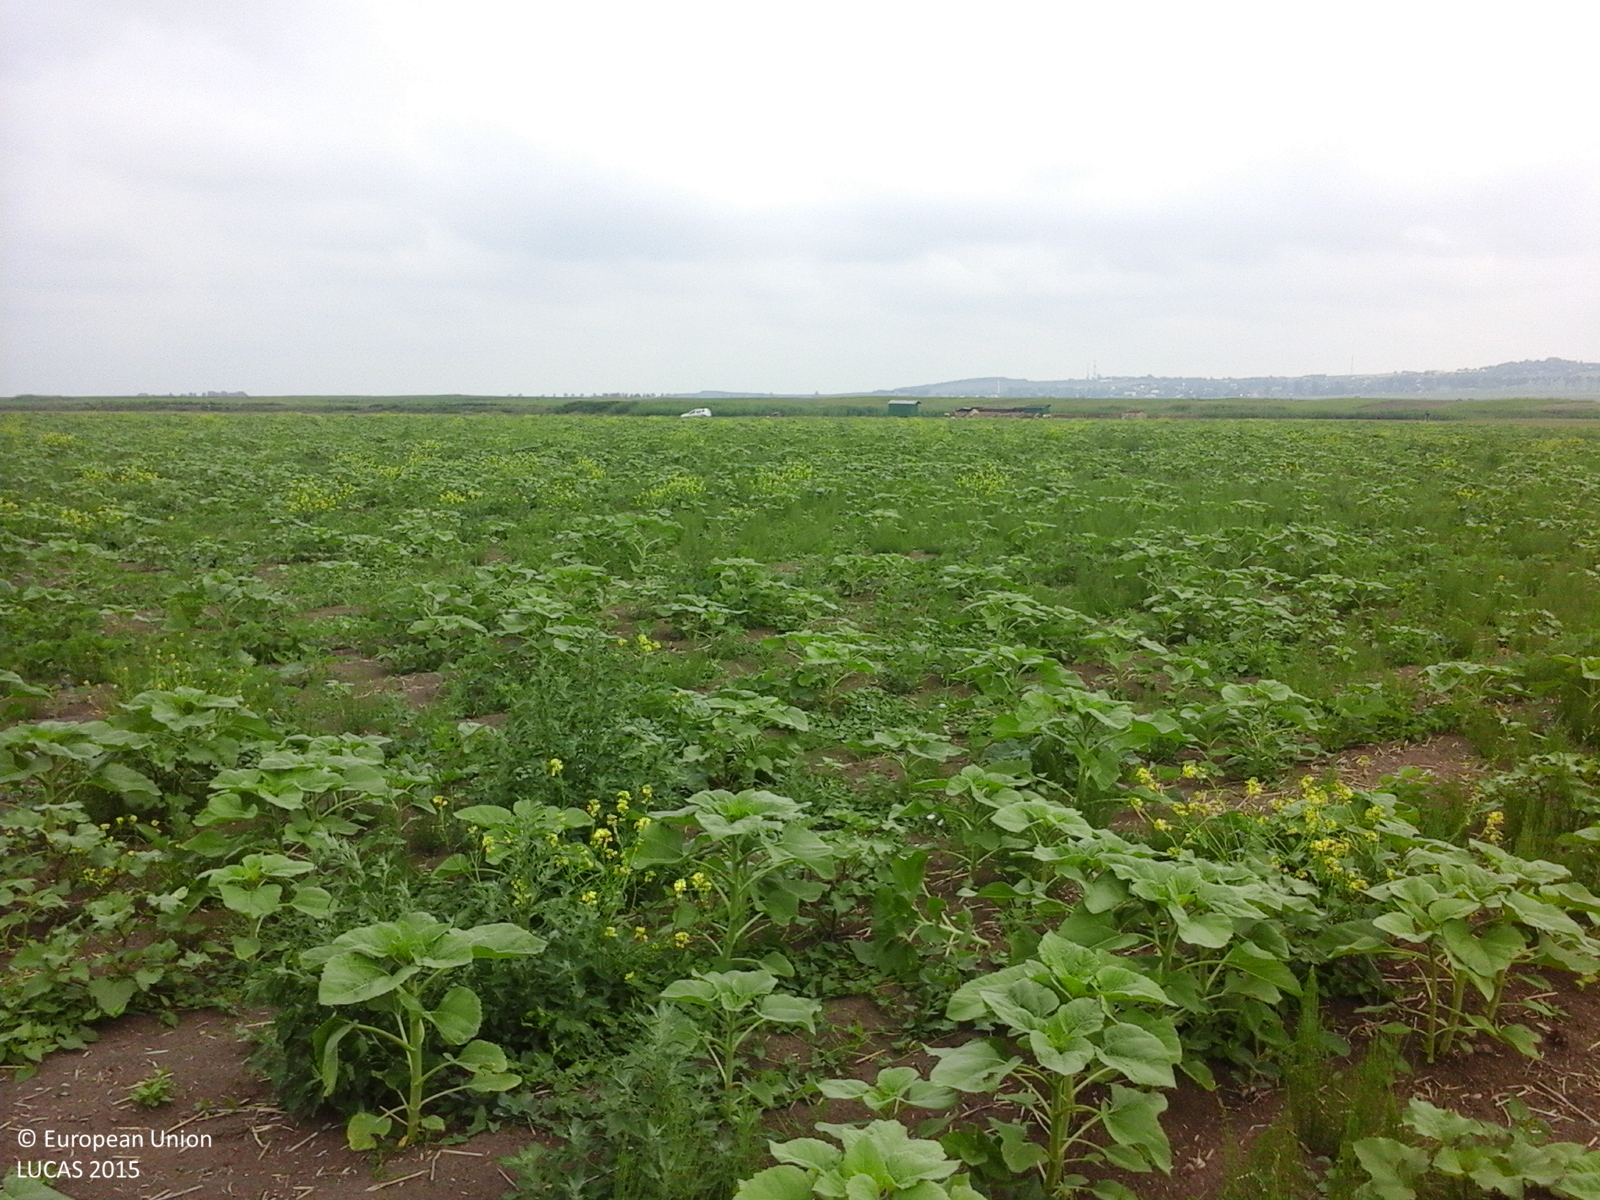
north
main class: Cropland
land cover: Sunflower
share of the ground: 25 - 50 %
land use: Agriculture (excluding fallow land and kitchen gardens)
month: June
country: RO
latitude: 47.7295
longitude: 26.4489
